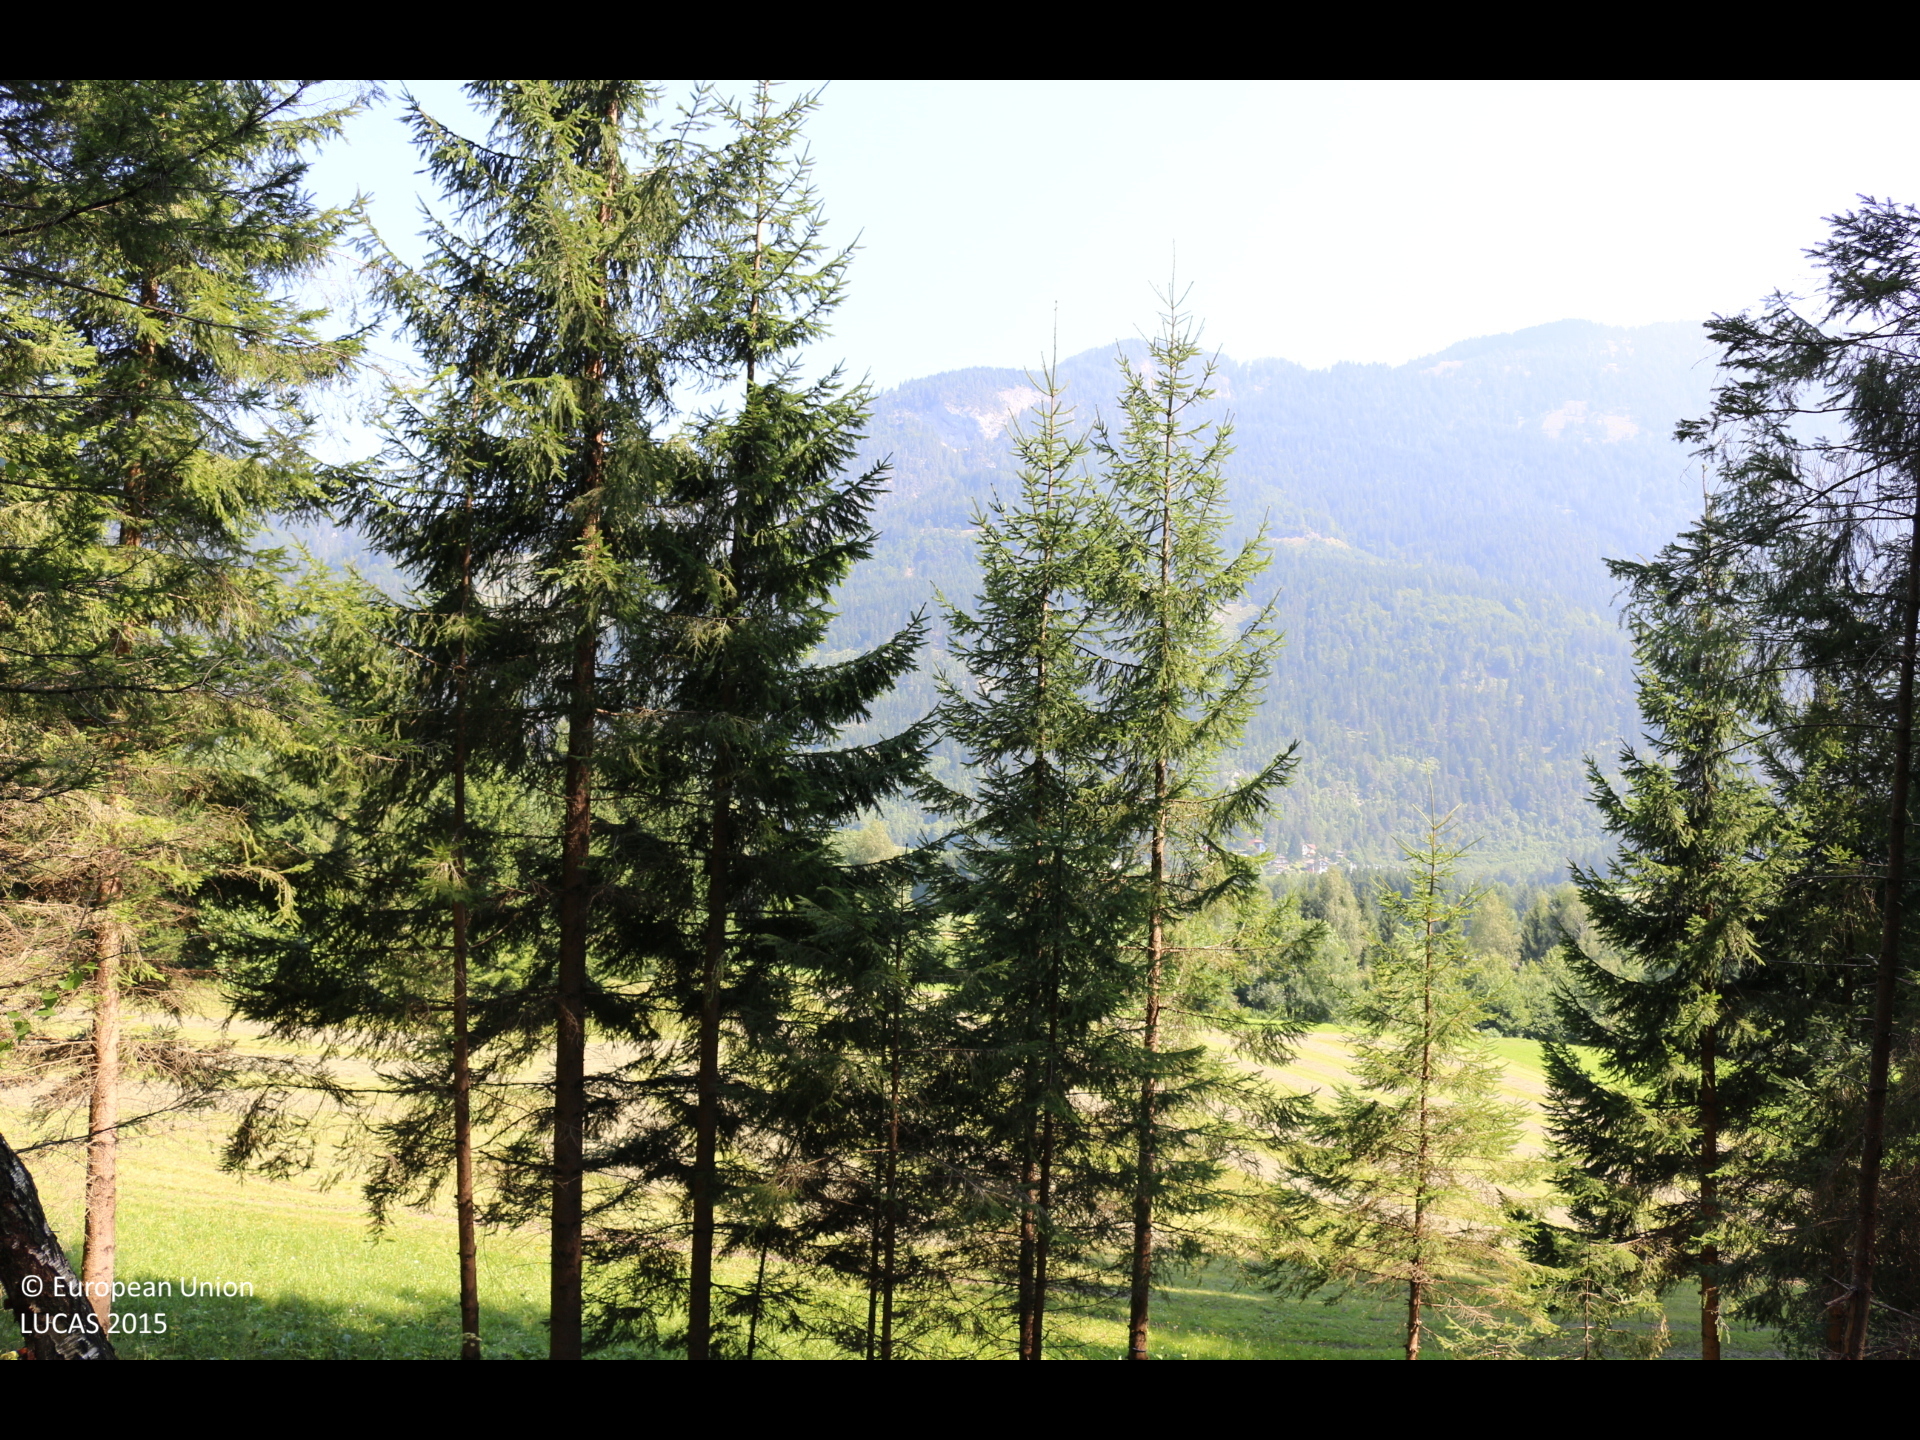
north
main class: Woodland
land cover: Spruce dominated coniferous woodland
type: alpine coniferous forest
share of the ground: > 75 %
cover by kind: coniferous forest trees 85 %, herbaceous plants 10 %, shrubs 5 %
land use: Forestry
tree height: > 5 m
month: August
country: AT
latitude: 46.6607
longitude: 13.3036
